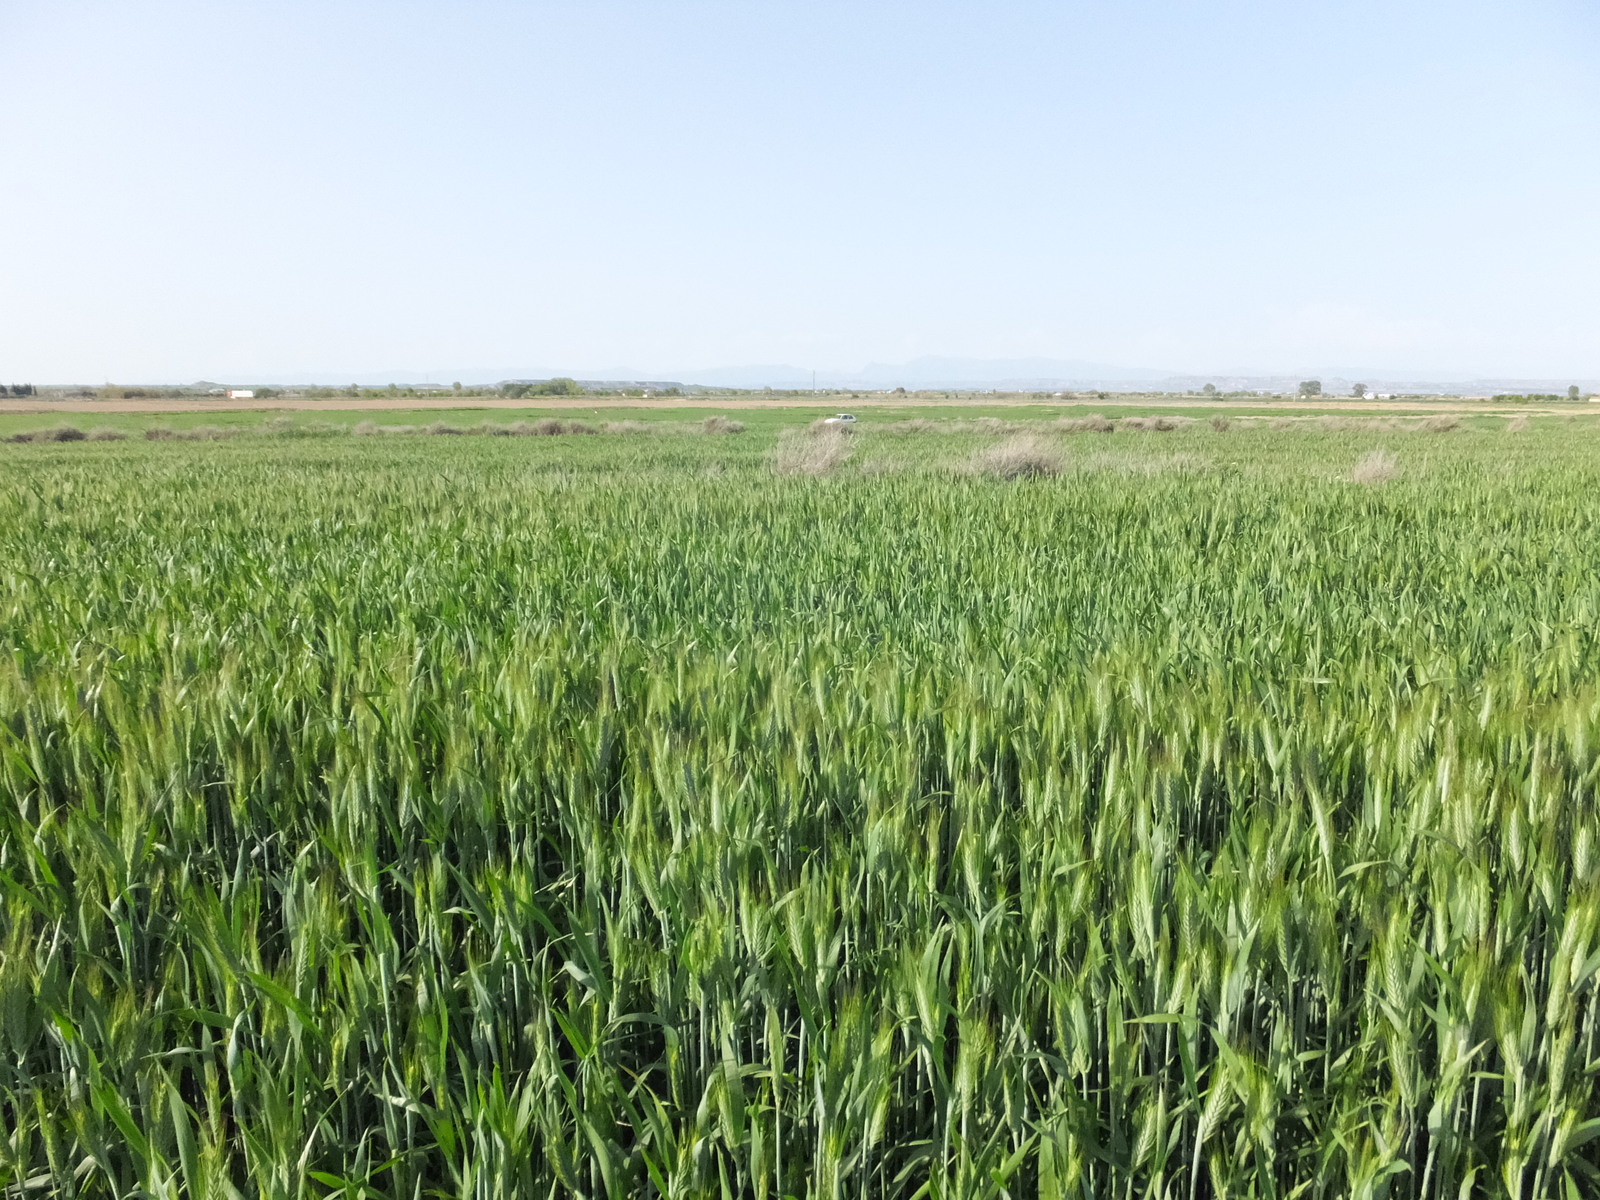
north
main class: Cropland
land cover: Durum wheat
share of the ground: > 75 %
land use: Agriculture (excluding fallow land and kitchen gardens)
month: April
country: ES
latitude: 41.7763
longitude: -0.3535
